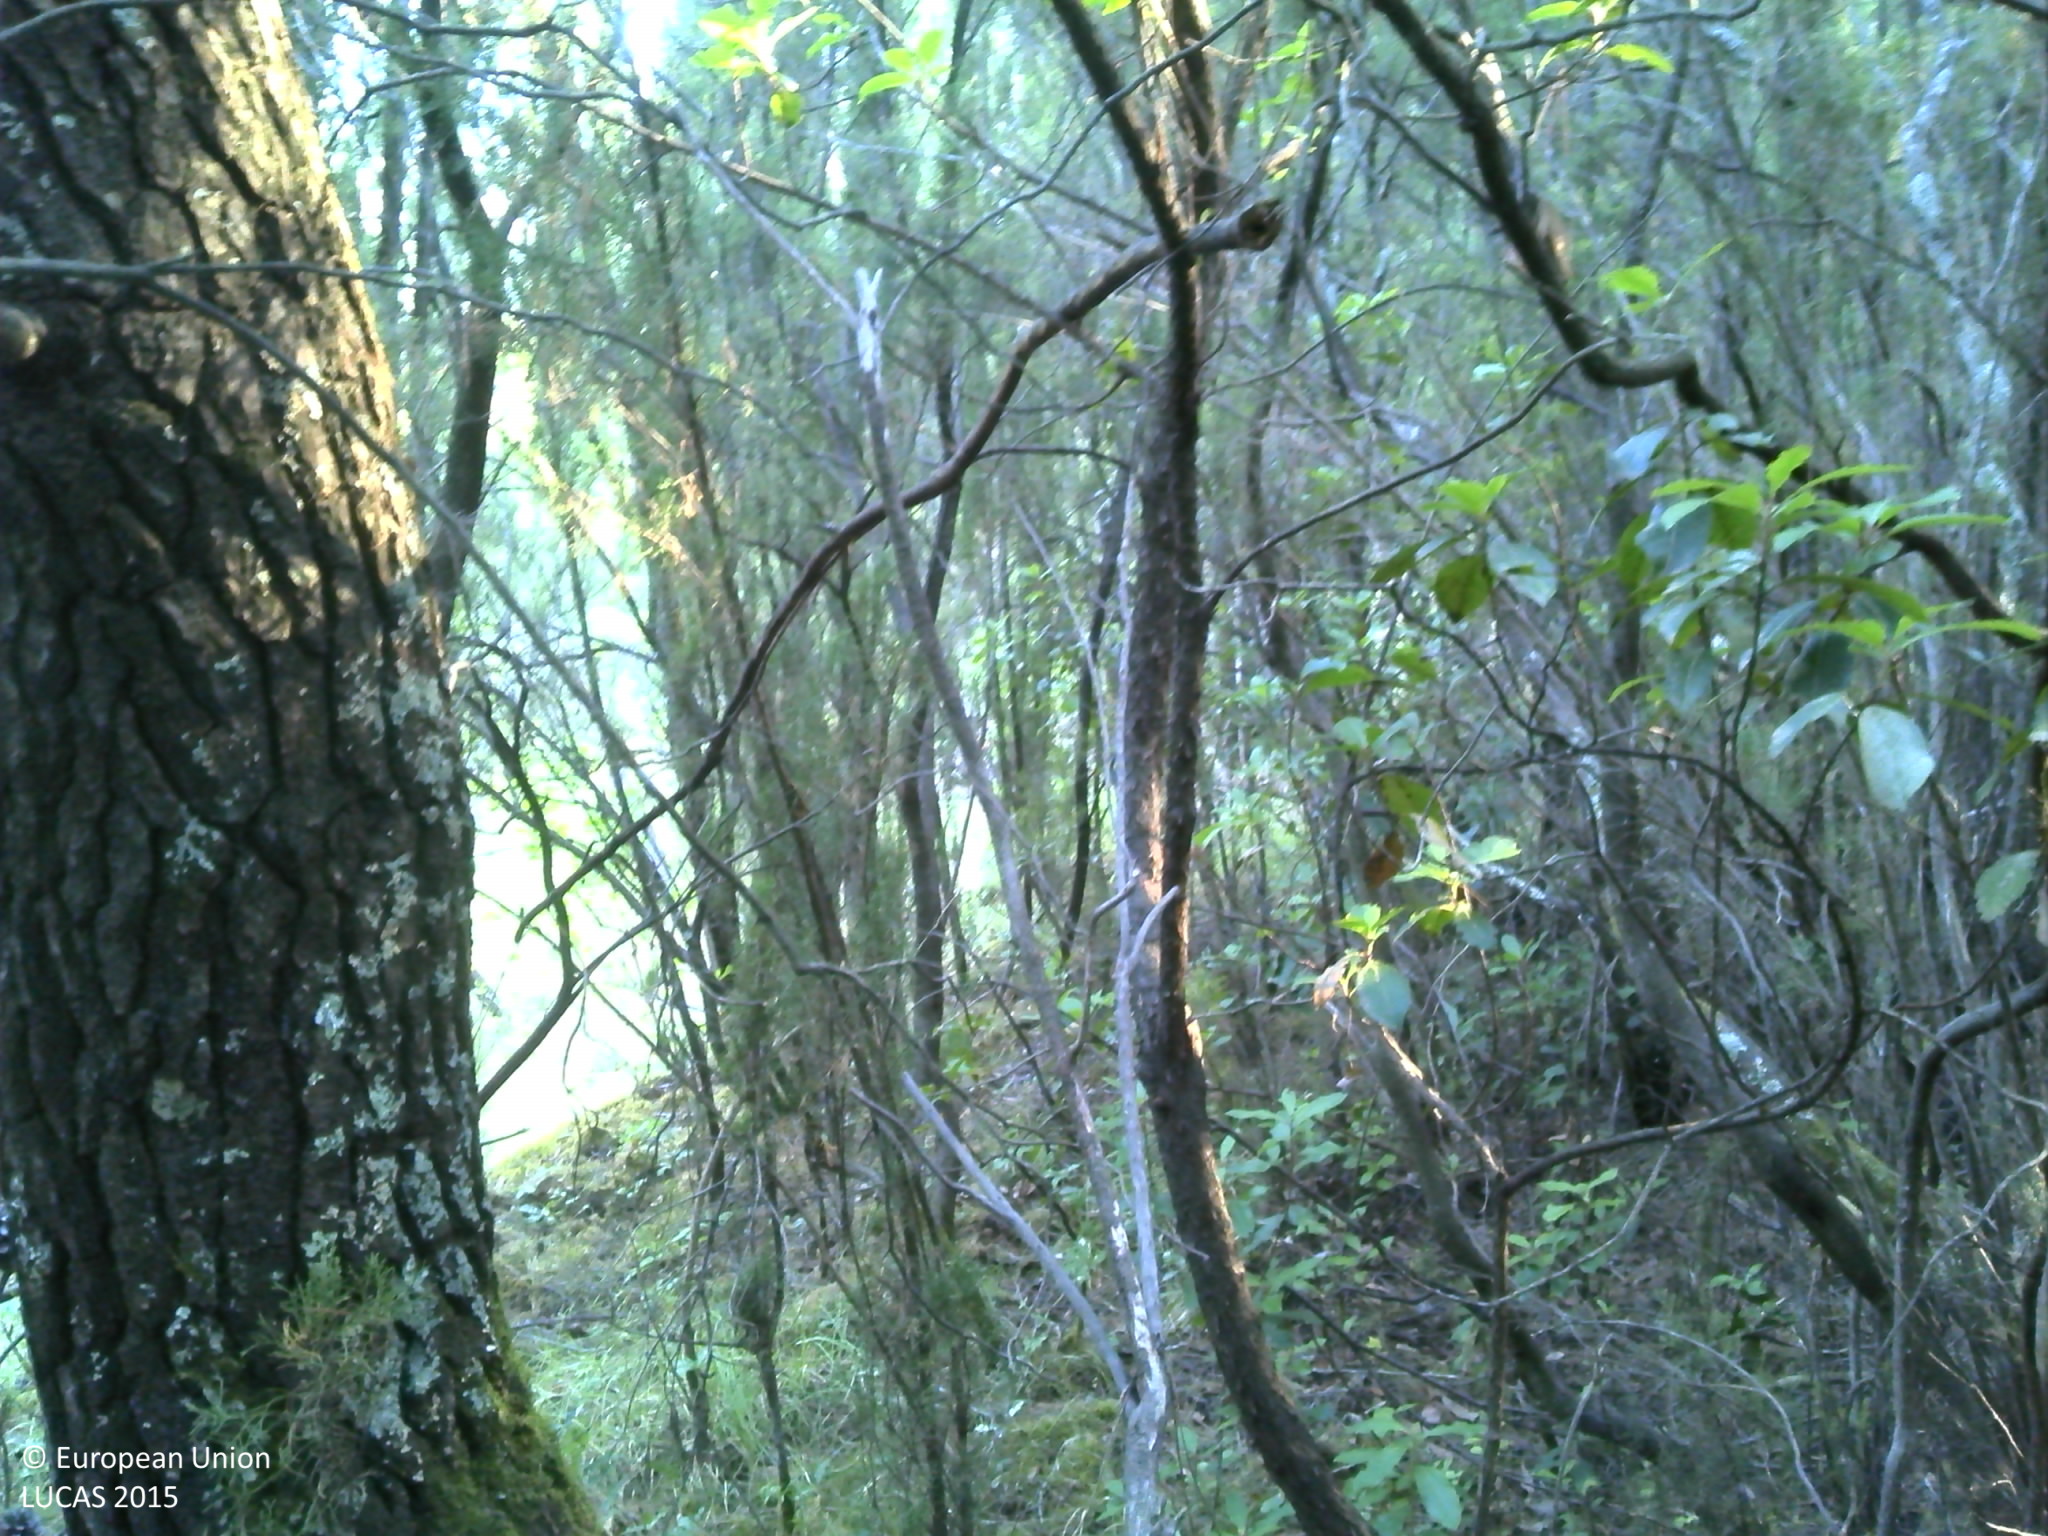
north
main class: Woodland
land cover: Other coniferous woodland
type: coniferous forest of the mediterranean region
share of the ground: > 75 %
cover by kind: coniferous forest trees 80 %, herbaceous plants 10 %, shrubs 5 %, consolidated bare surface 5 %
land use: Semi-natural and natural areas not in use
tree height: > 5 m
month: July
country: HR
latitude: 42.5222
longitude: 18.4019
